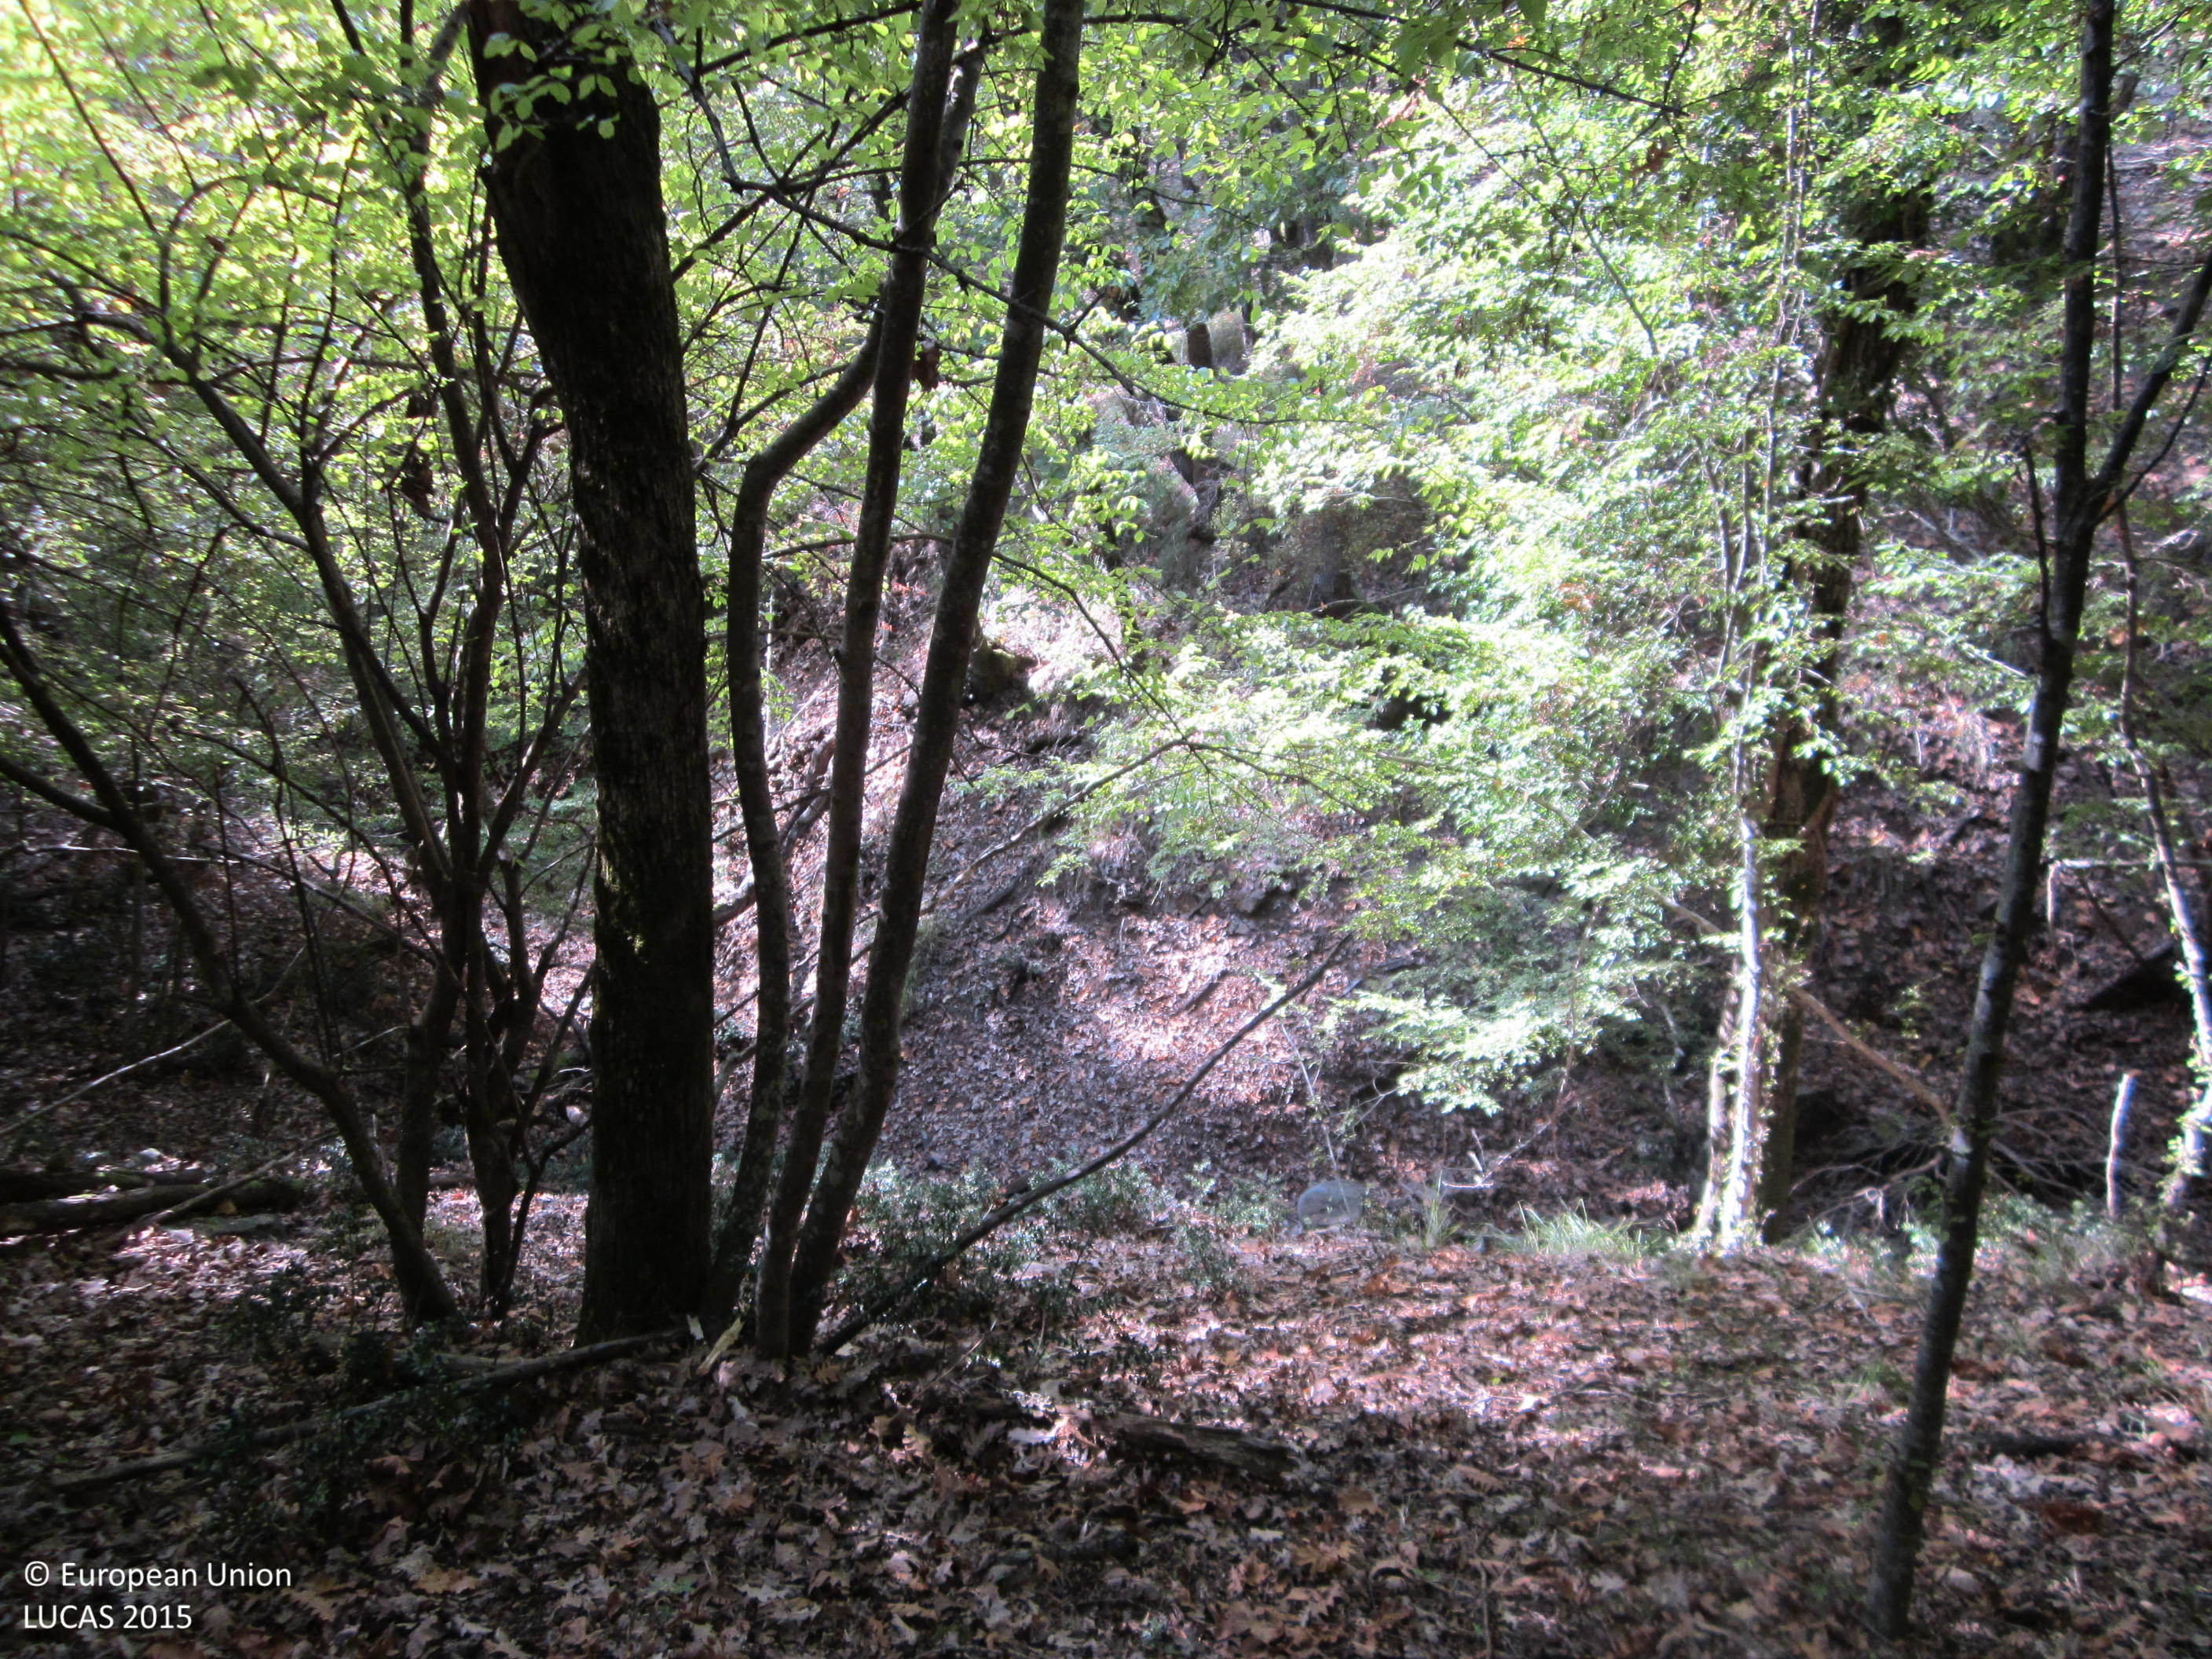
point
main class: Woodland
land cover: Broadleaved woodland
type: thermophilous deciduous forest
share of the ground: > 75 %
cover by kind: broadleaved forest trees 90 %, herbaceous plants 5 %, unconsolidated bare surface 5 %
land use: Forestry
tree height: > 5 m
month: September
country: BG
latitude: 42.3075
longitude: 27.7489
